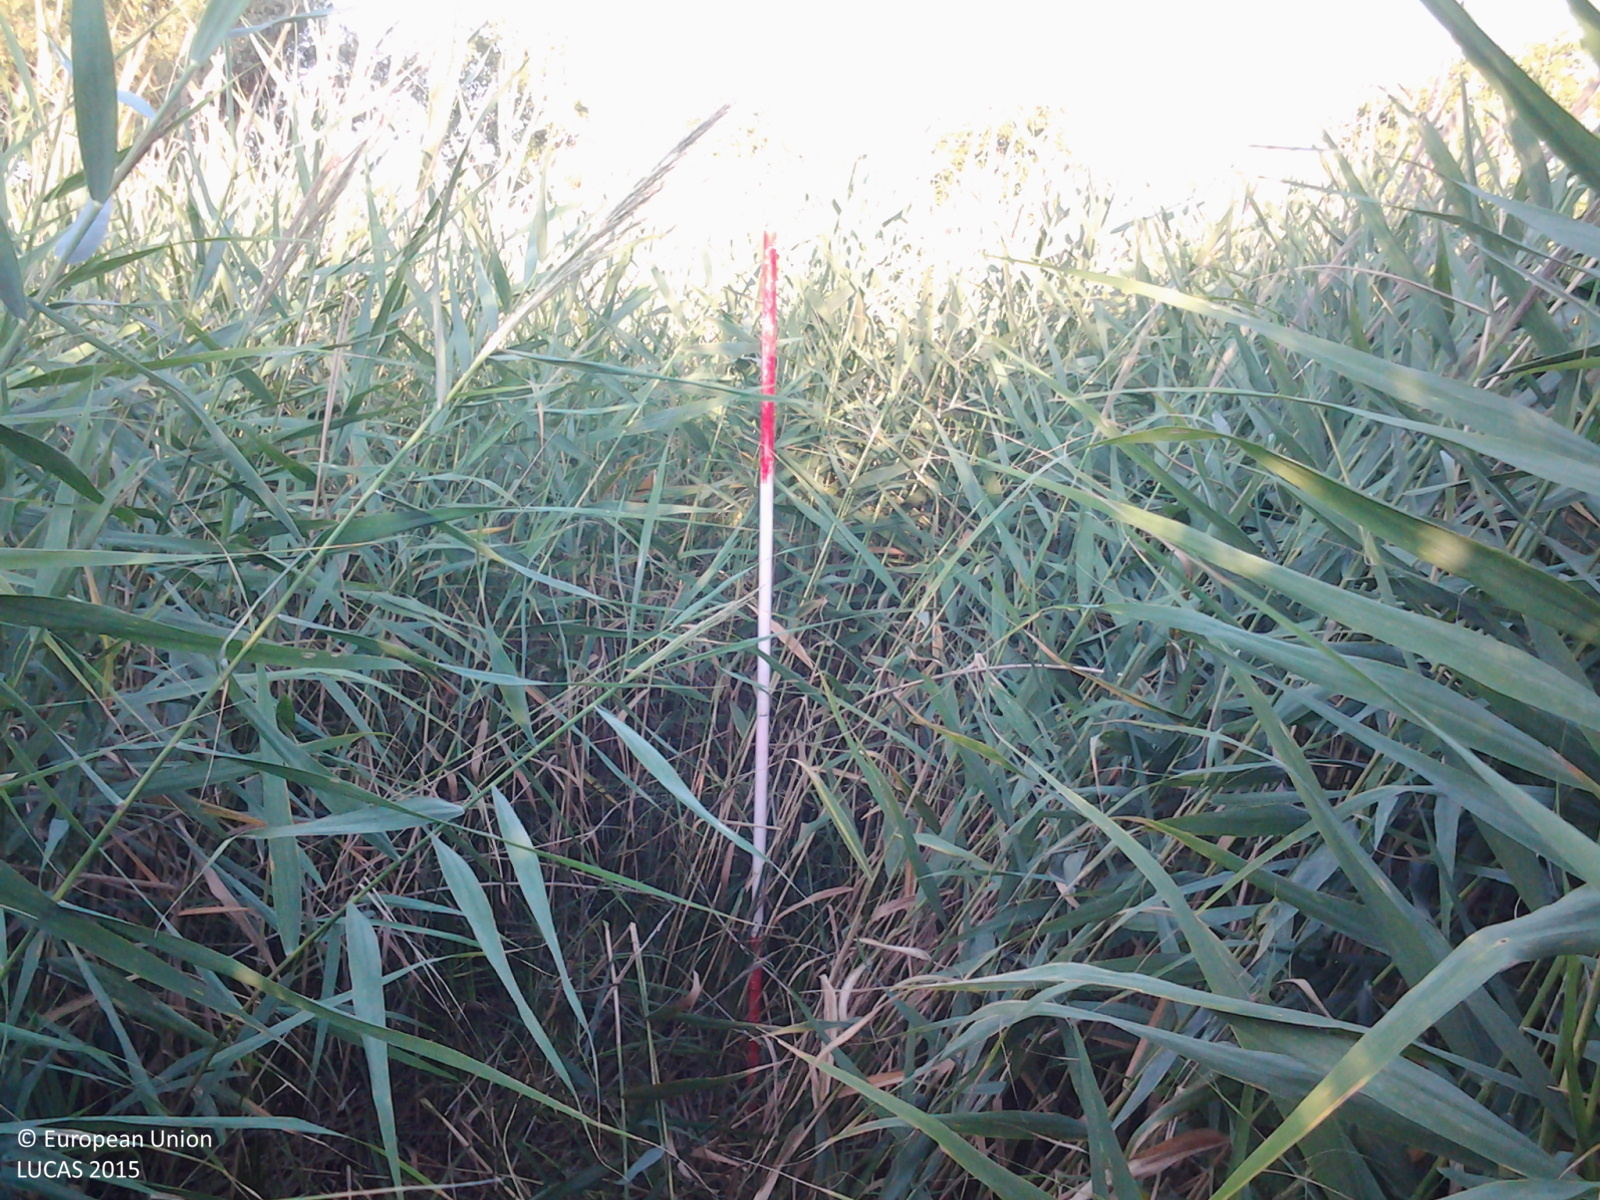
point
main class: Grassland
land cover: Spontaneously vegetated surfaces
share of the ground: > 75 %
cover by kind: herbaceous plants 100 %
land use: Semi-natural and natural areas not in use
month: August
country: HU
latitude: 46.8815
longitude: 21.6017
